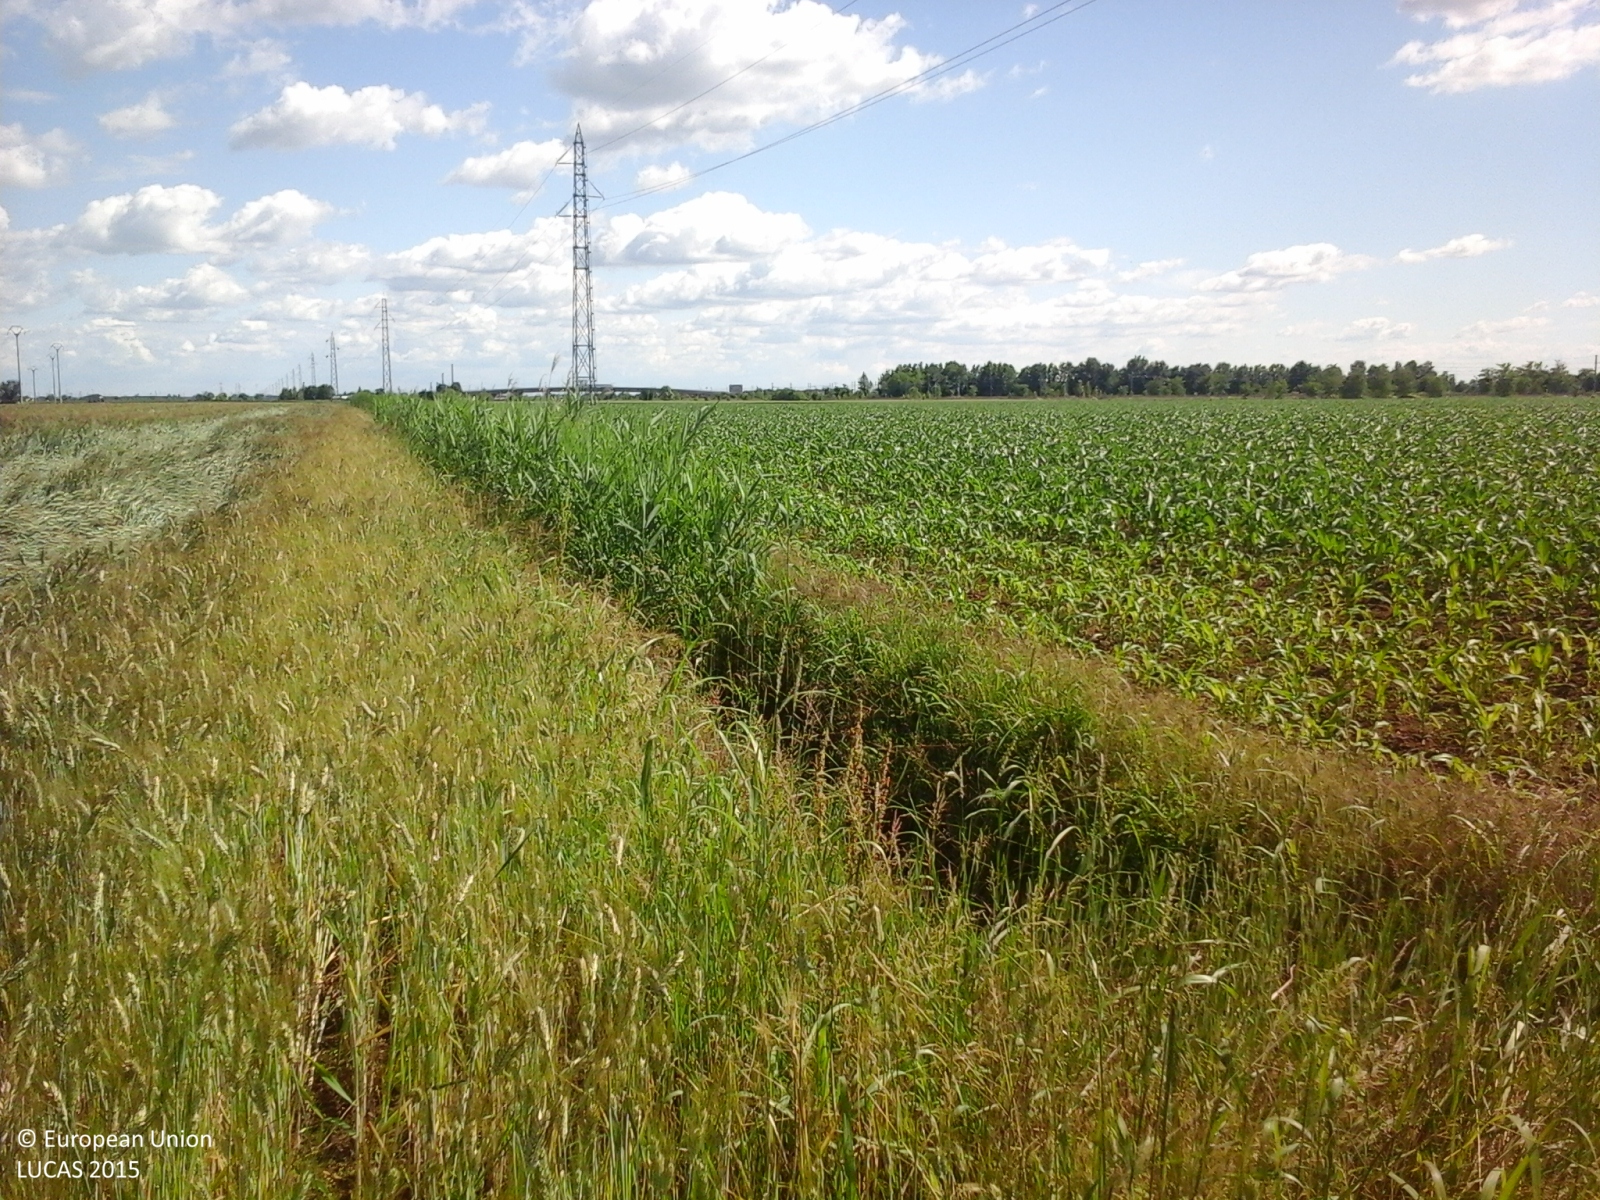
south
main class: Cropland
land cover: Common wheat
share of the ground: > 75 %
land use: Agriculture (excluding fallow land and kitchen gardens)
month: May
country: IT
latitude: 45.1381
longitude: 11.1043
